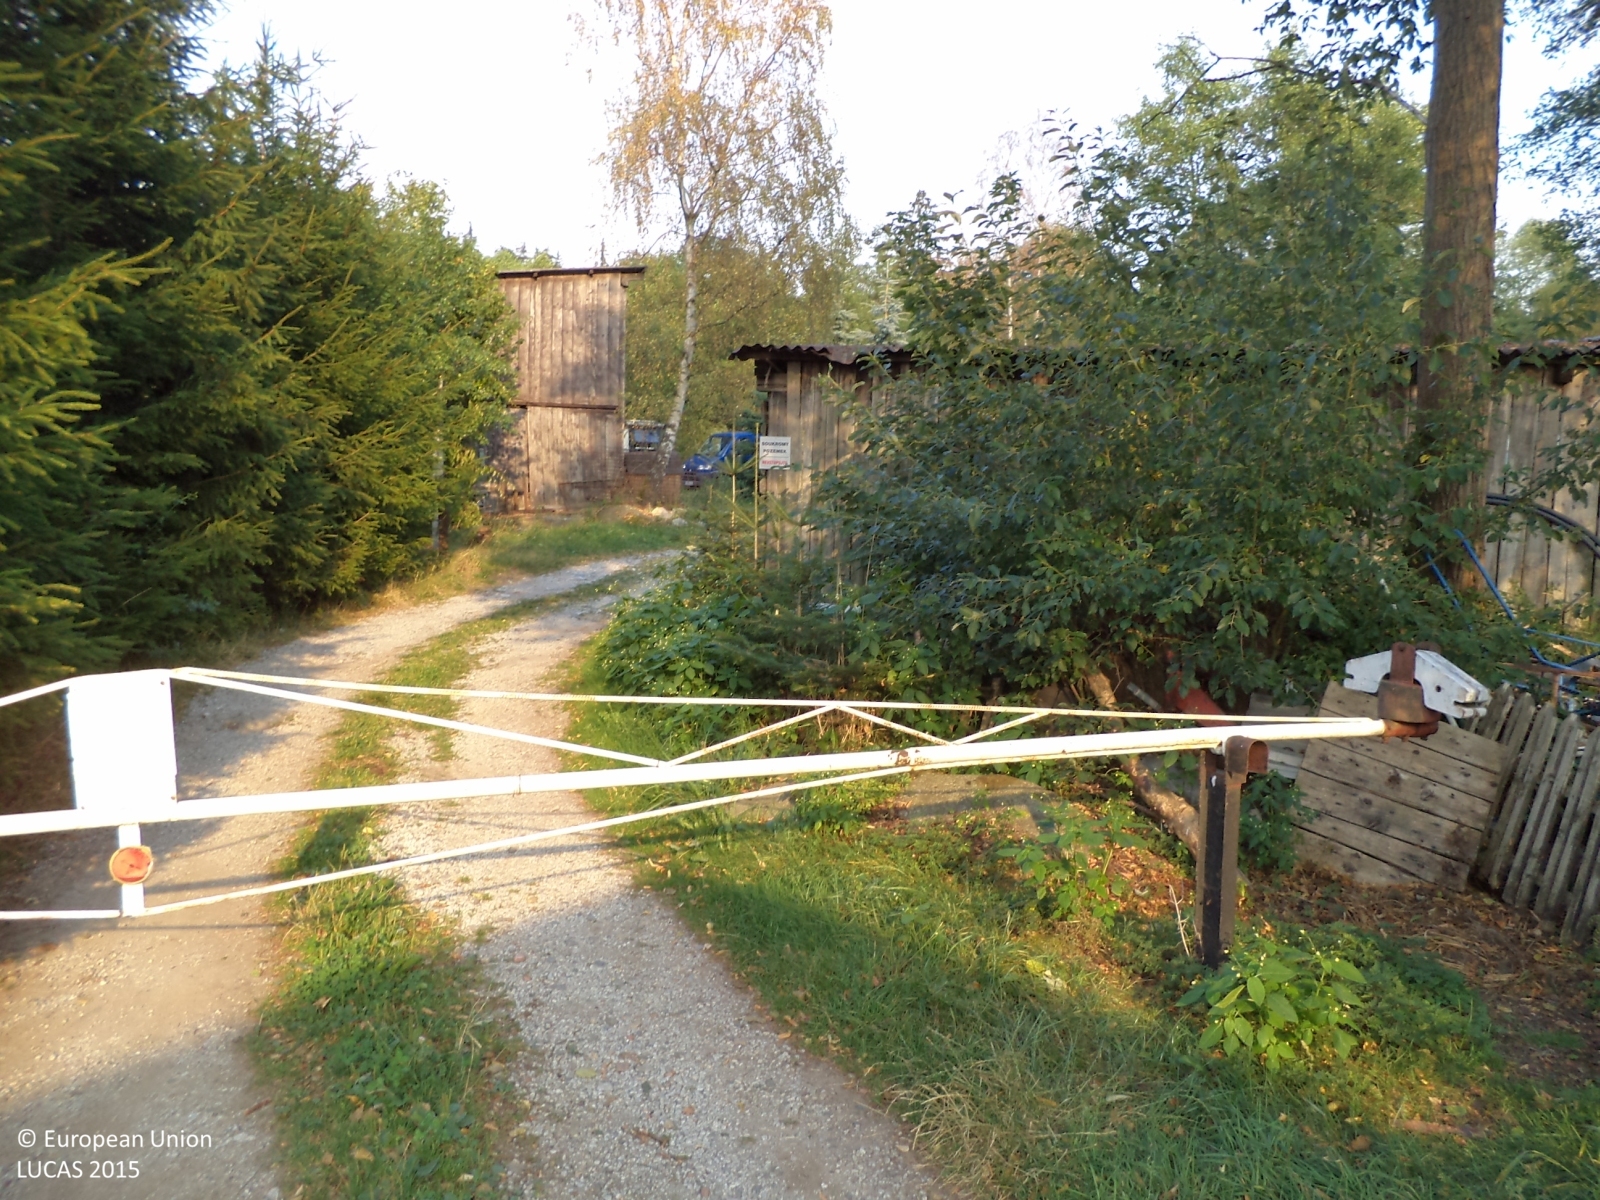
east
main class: Woodland
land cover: Spruce dominated coniferous woodland
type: hemiboreal forest and nemoral coniferous forest and mixed broadleaved-coniferous forest
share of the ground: > 75 %
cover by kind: coniferous forest trees 100 %
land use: Forestry
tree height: > 5 m
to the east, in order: Spruce dominated coniferous woodland
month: August
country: CZ
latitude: 49.5564
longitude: 14.4666
